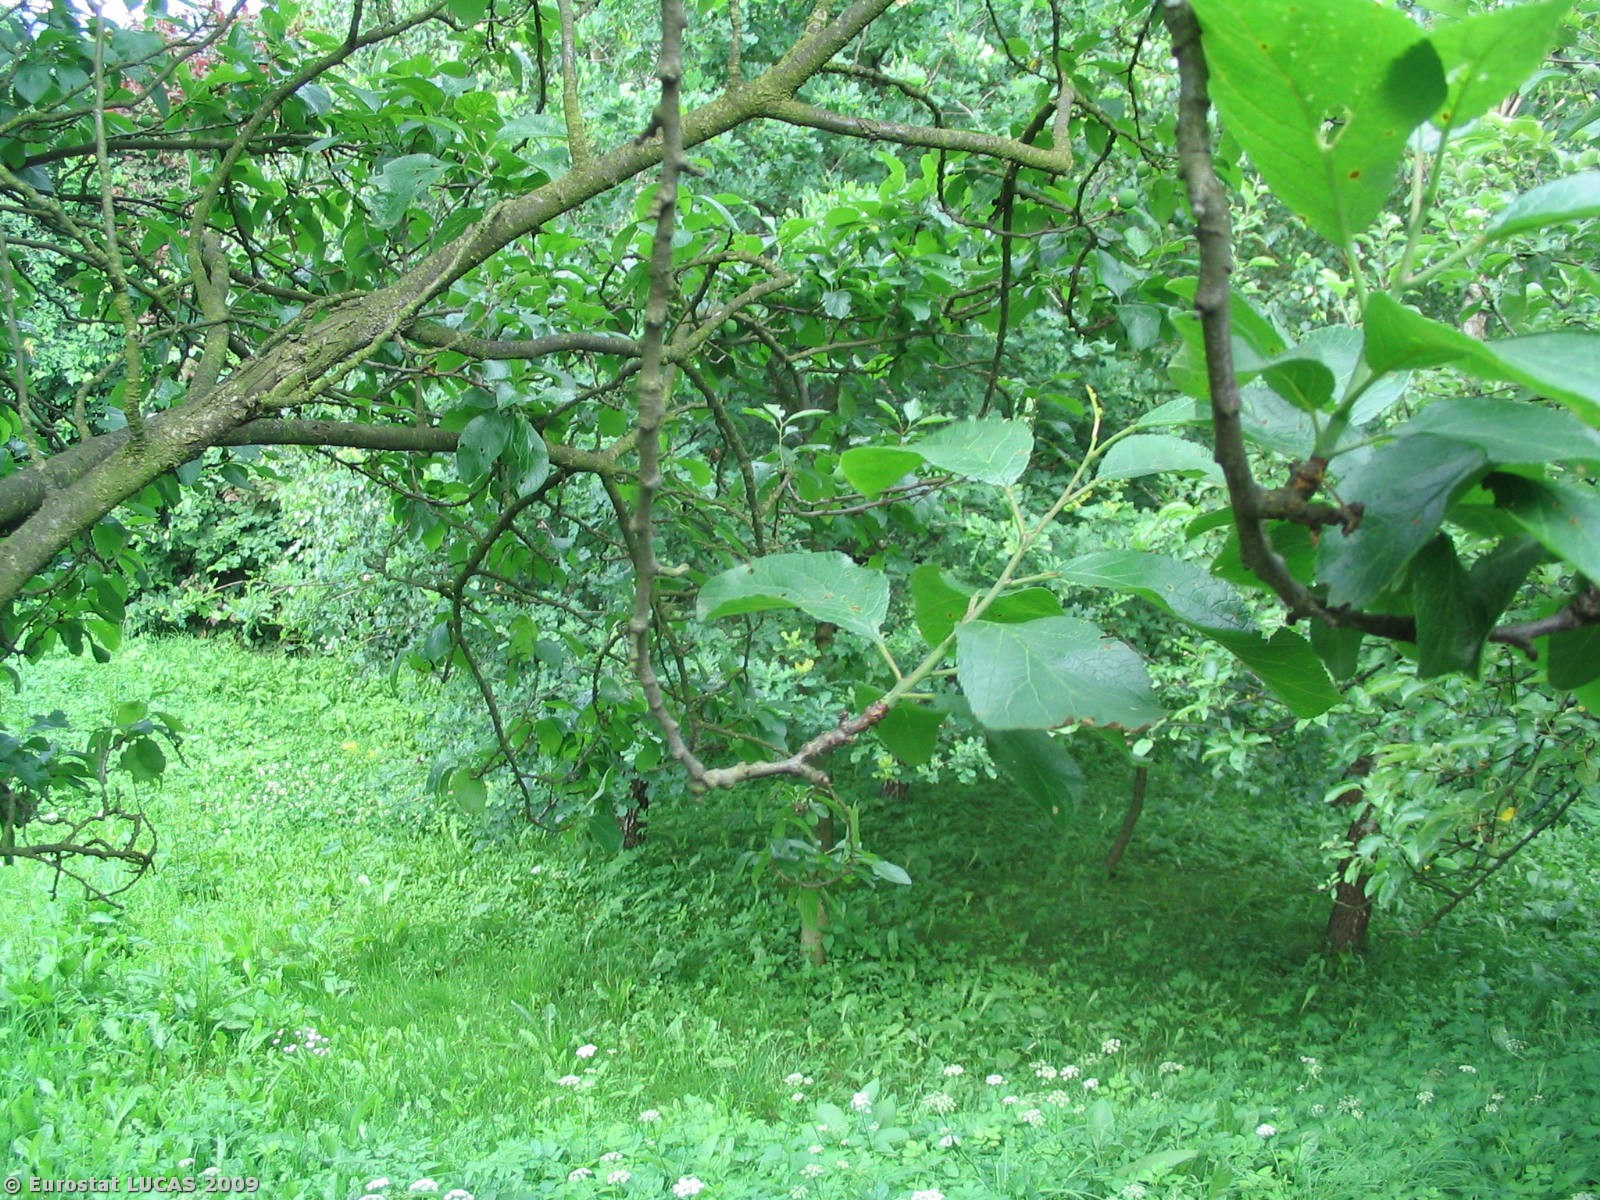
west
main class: Cropland
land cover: Apple fruit
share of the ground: 50 - 75 %
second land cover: Grassland with sparse tree/shrub cover
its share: > 75 %
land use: Kitchen garden
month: June
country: CZ
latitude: 49.5762
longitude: 18.7468
